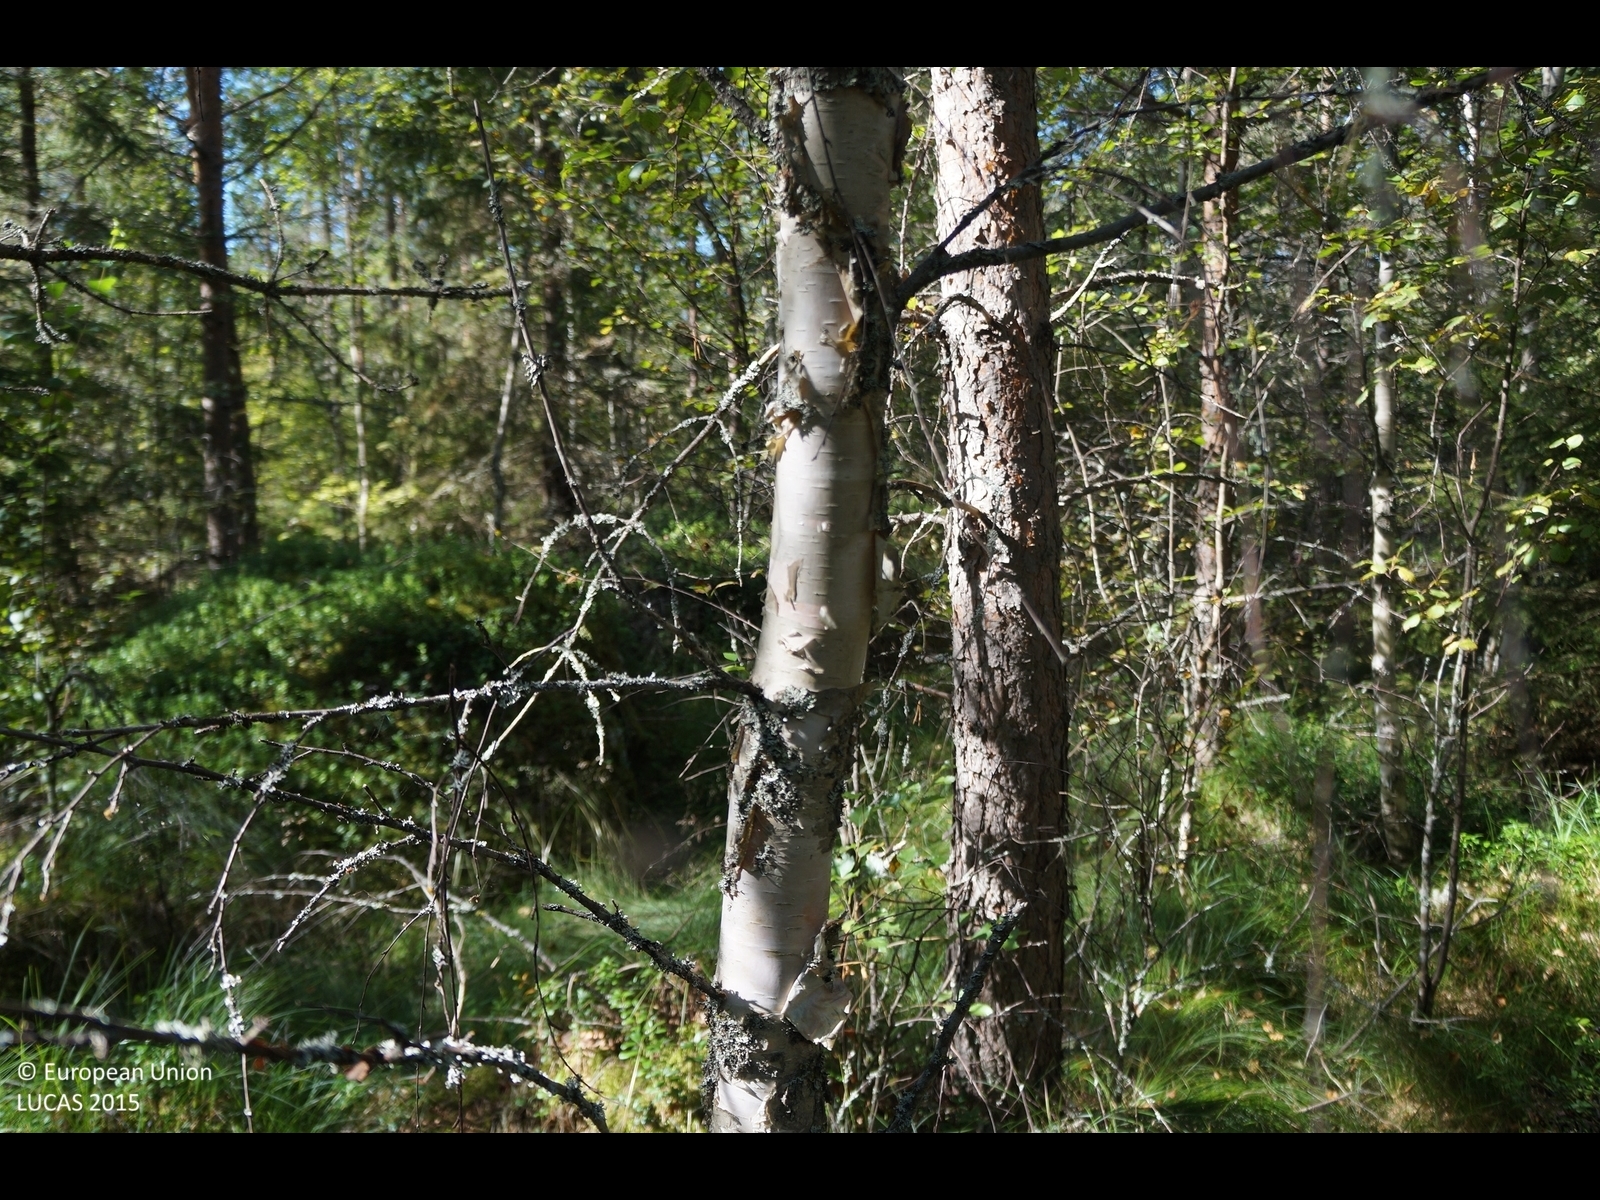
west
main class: Woodland
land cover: Pine dominated mixed woodland
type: boreal forest
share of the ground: 50 - 75 %
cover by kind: coniferous forest trees 50 %, broadleaved forest trees 20 %, herbaceous plants 15 %, shrubs 10 %, lichens and mosses 5 %
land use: Forestry
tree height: > 5 m
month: August
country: FI
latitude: 63.9640
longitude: 23.7217
